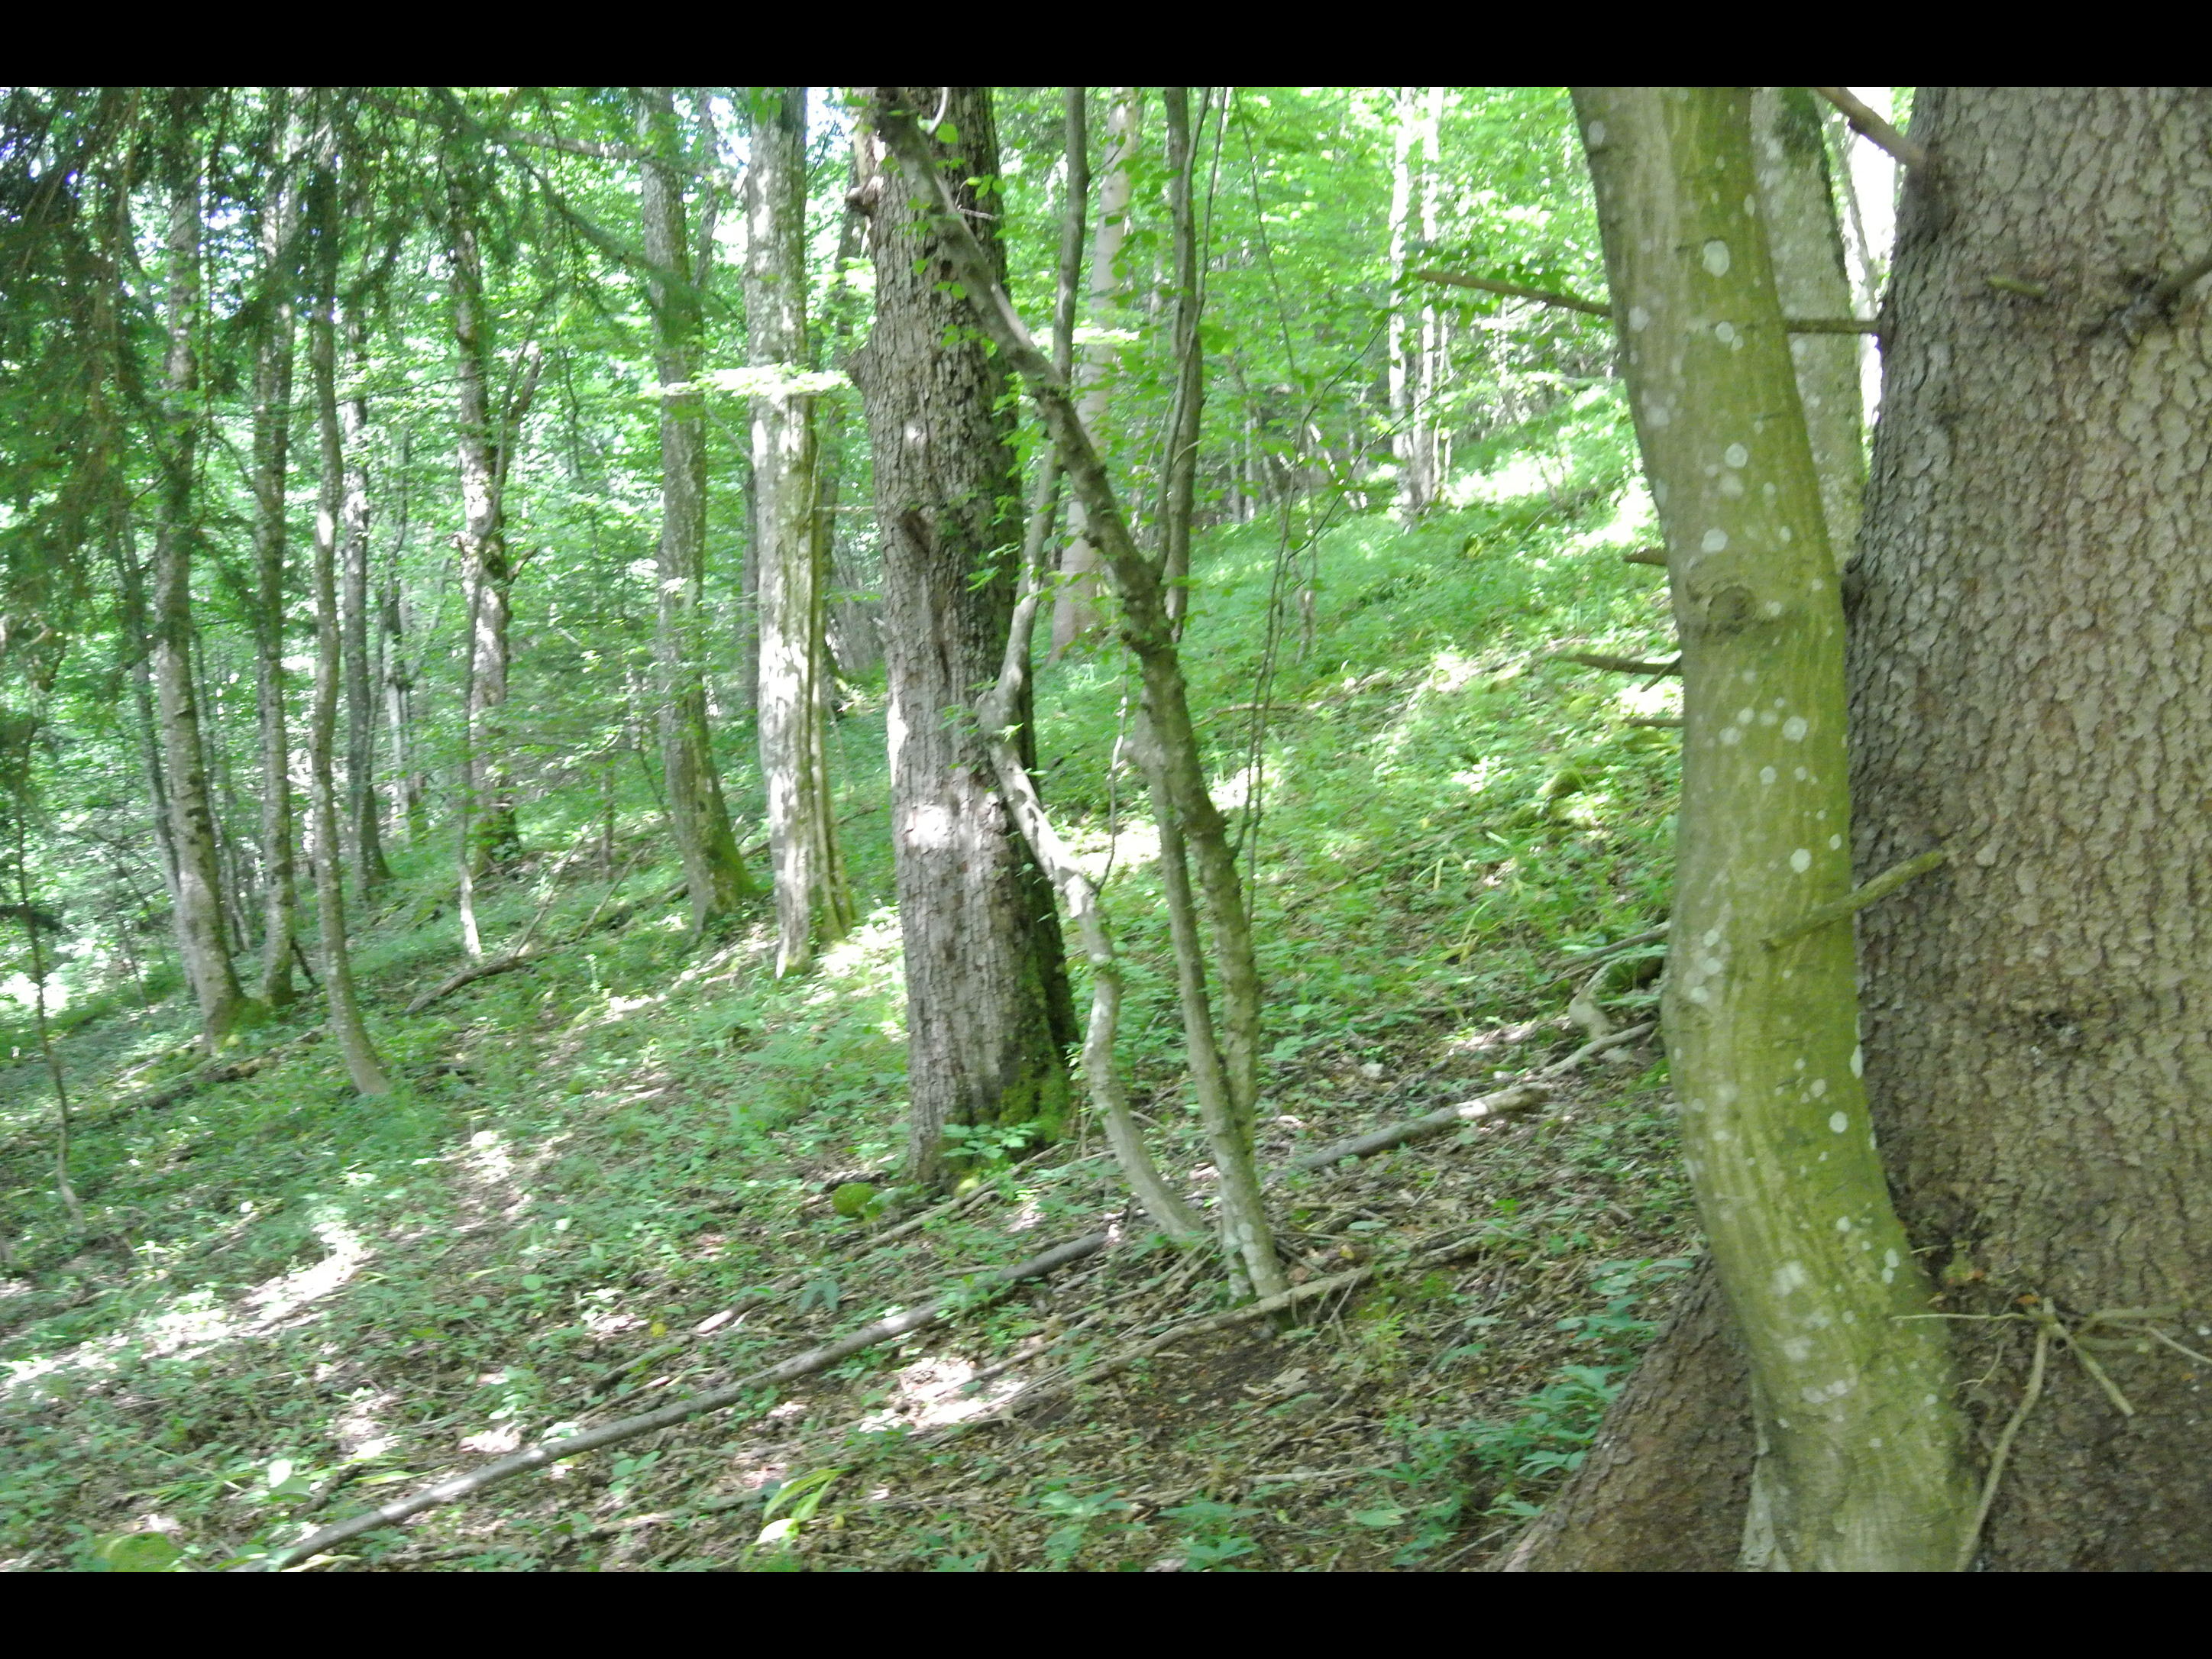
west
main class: Woodland
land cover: Spruce dominated mixed woodland
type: mountainous beech forest
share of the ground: > 75 %
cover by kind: broadleaved forest trees 65 %, coniferous forest trees 35 %
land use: Forestry
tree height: > 5 m
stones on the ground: < 10 %
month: June
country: AT
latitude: 47.9471
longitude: 15.3973
